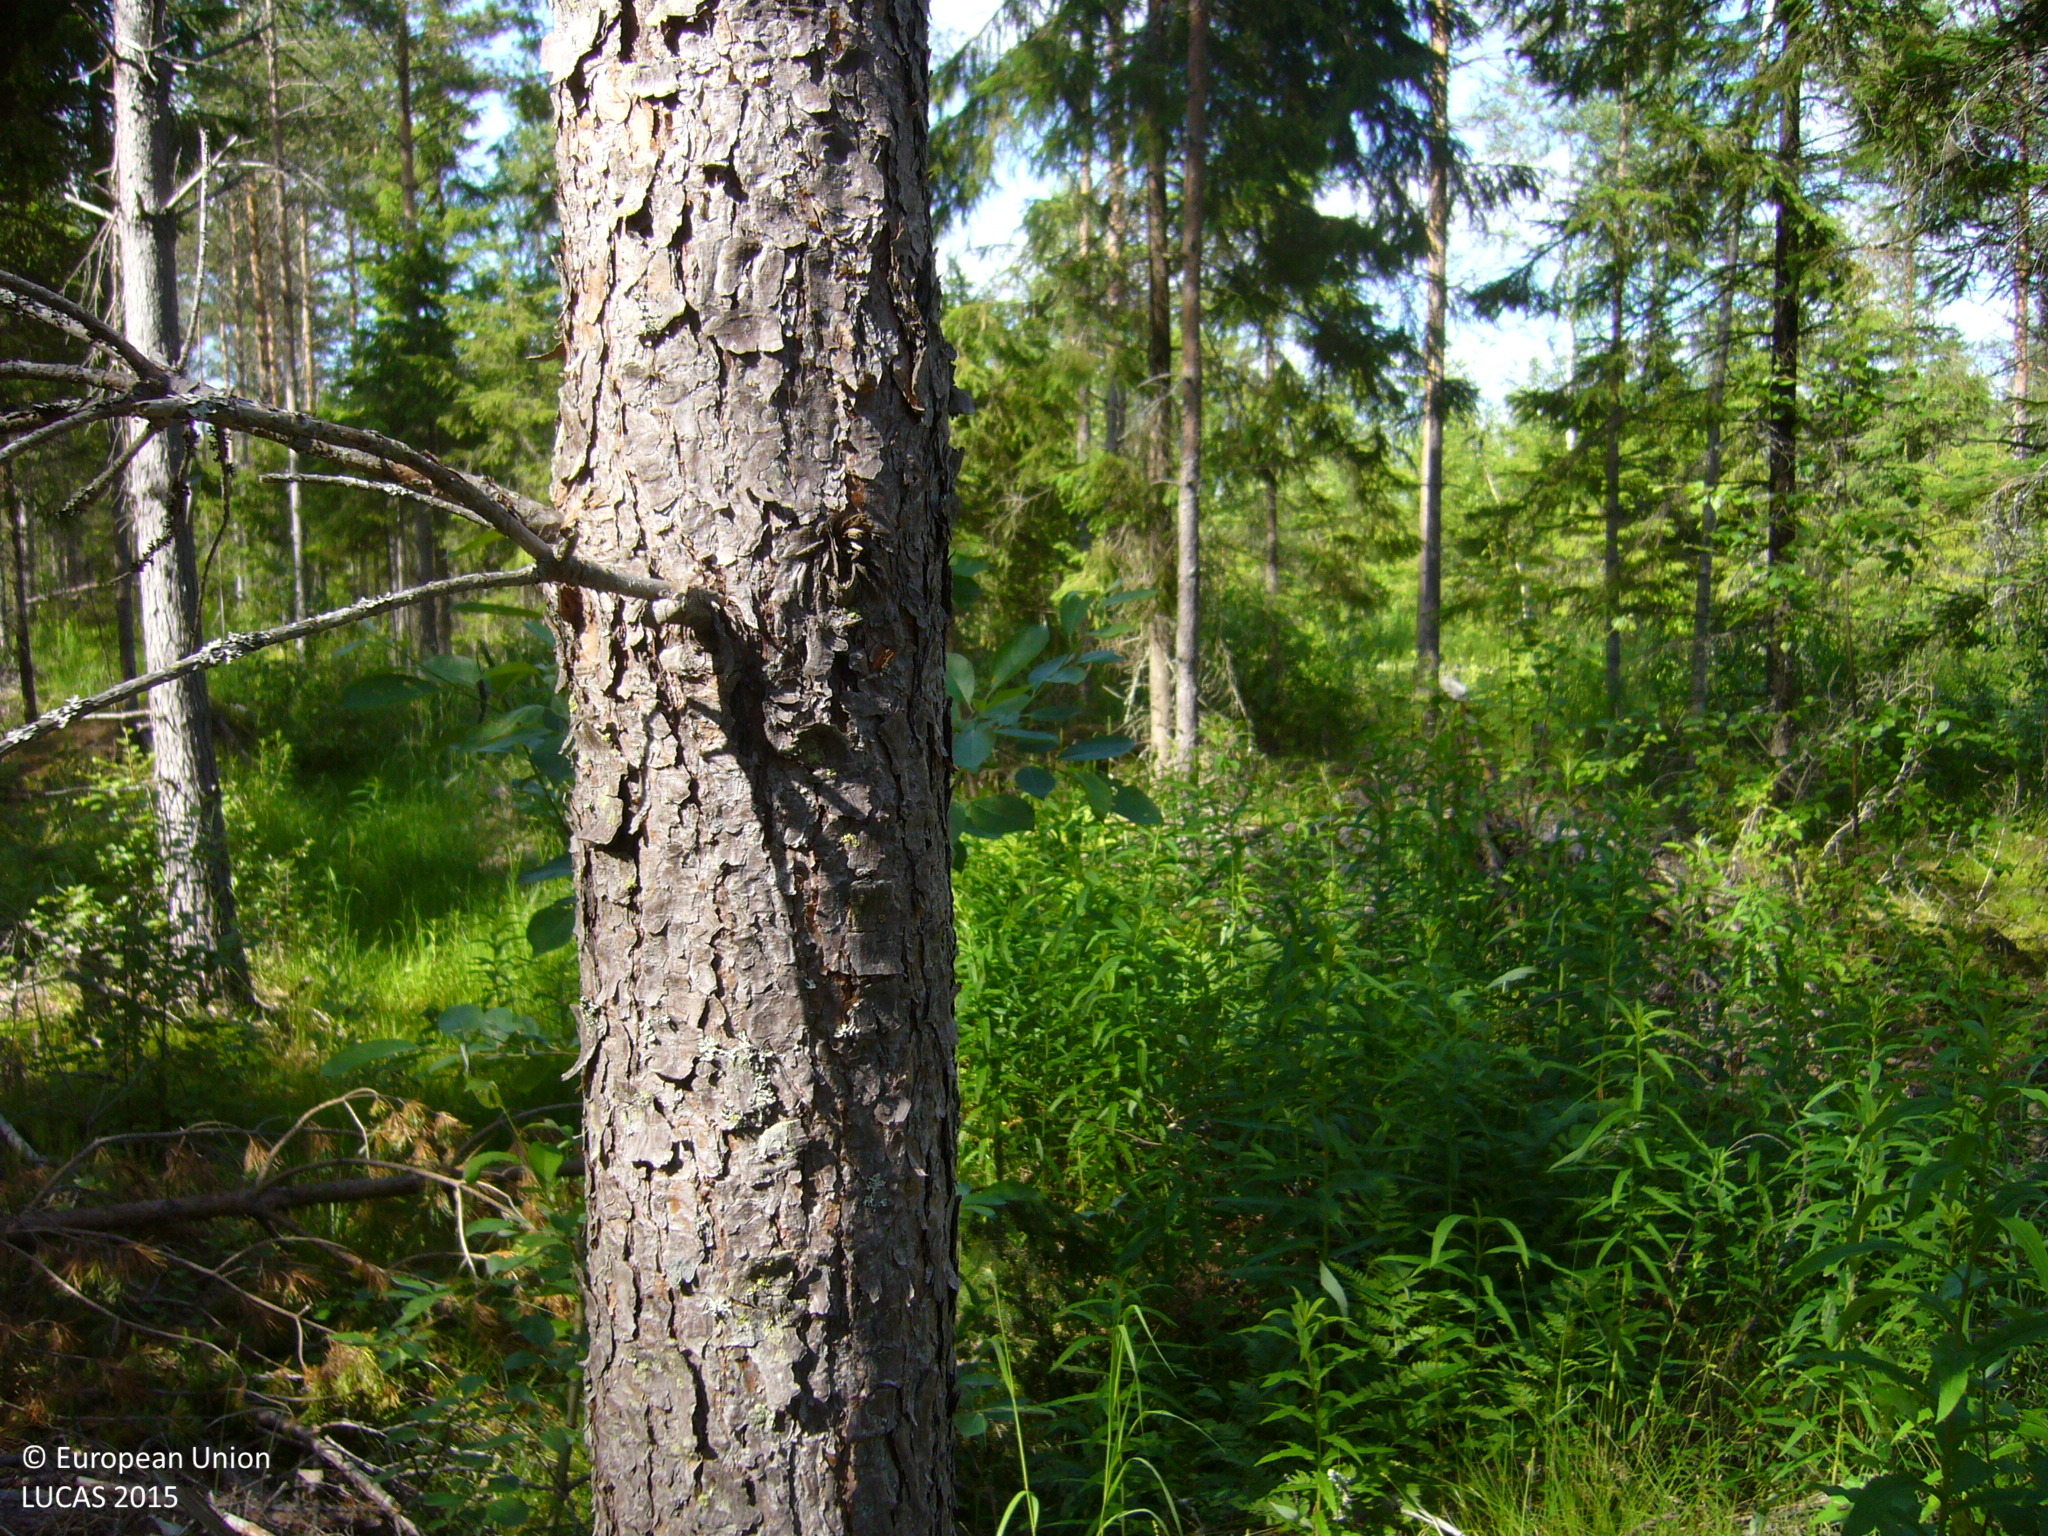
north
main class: Woodland
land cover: Pine dominated coniferous woodland
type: boreal forest
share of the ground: 50 - 75 %
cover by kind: coniferous forest trees 60 %, shrubs 40 %
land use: Forestry
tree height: > 5 m
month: July
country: FI
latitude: 63.3443
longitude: 26.2859
